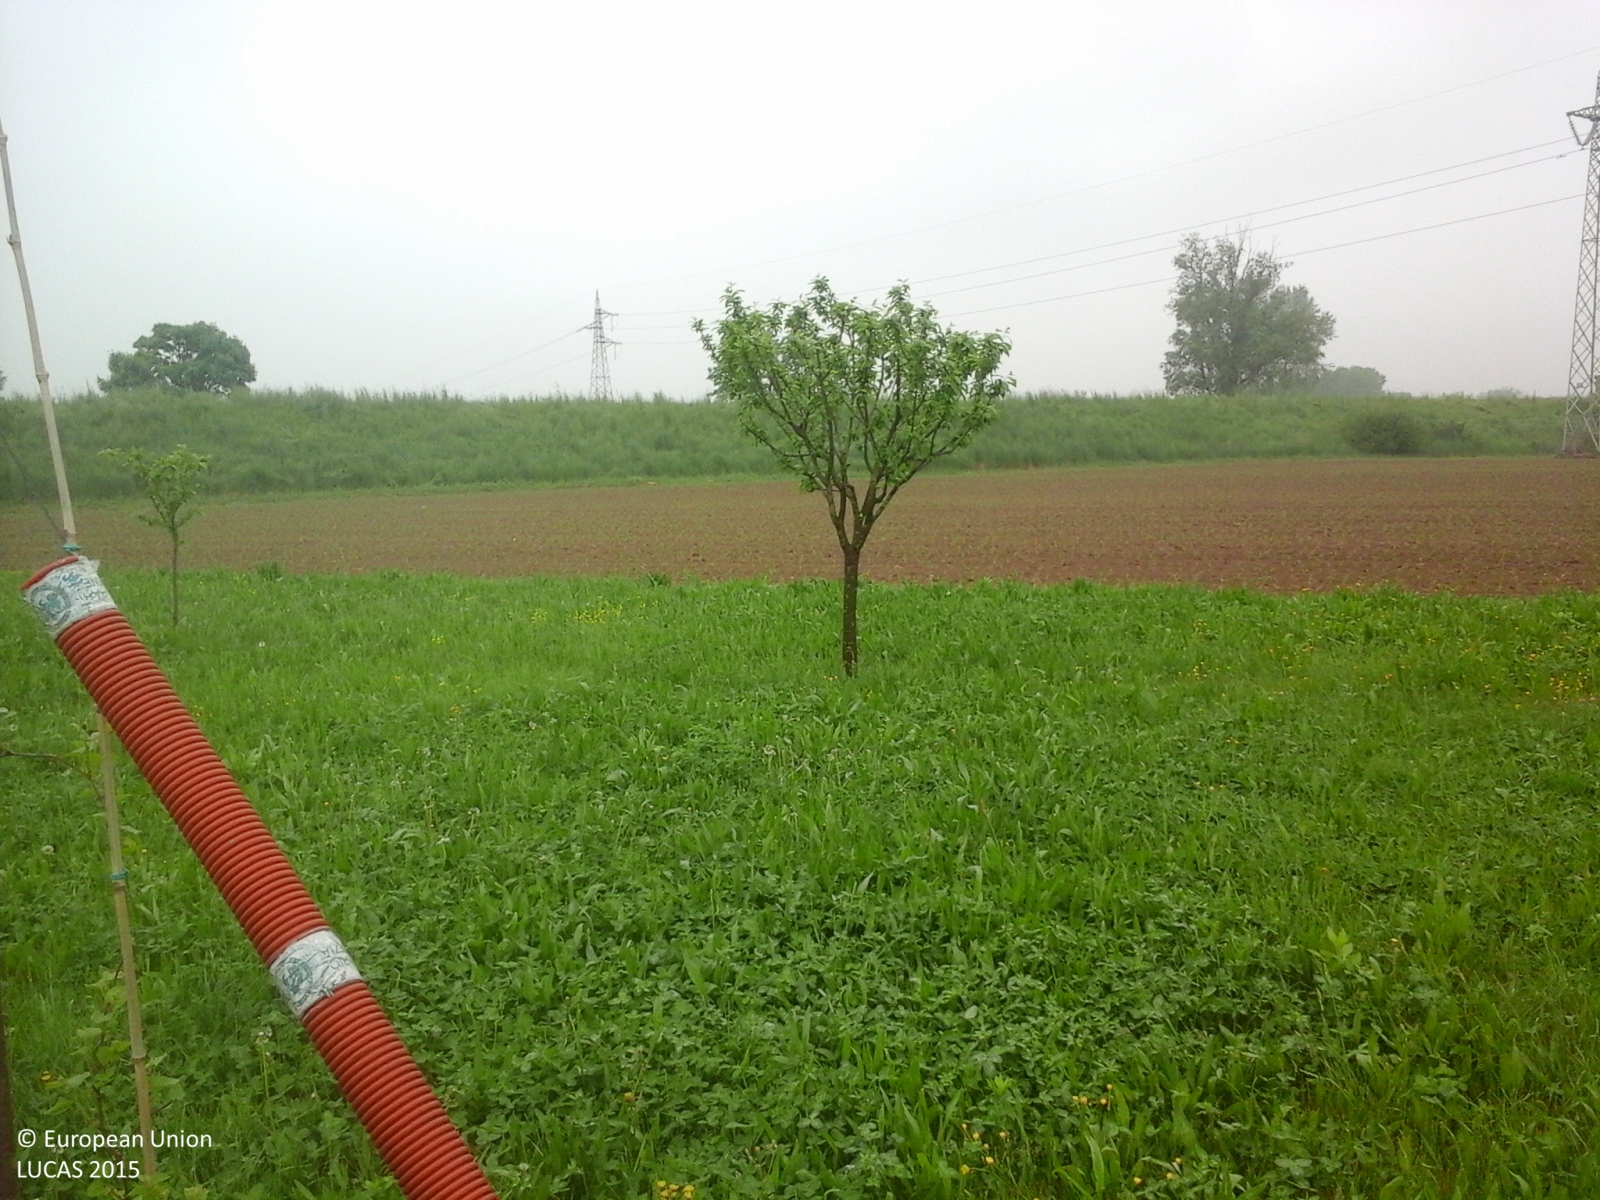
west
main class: Cropland
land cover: Pear fruit
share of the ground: 10 - 25 %
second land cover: Spontaneously vegetated surfaces
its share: > 75 %
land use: Kitchen garden
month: April
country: IT
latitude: 45.3787
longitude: 11.9251
